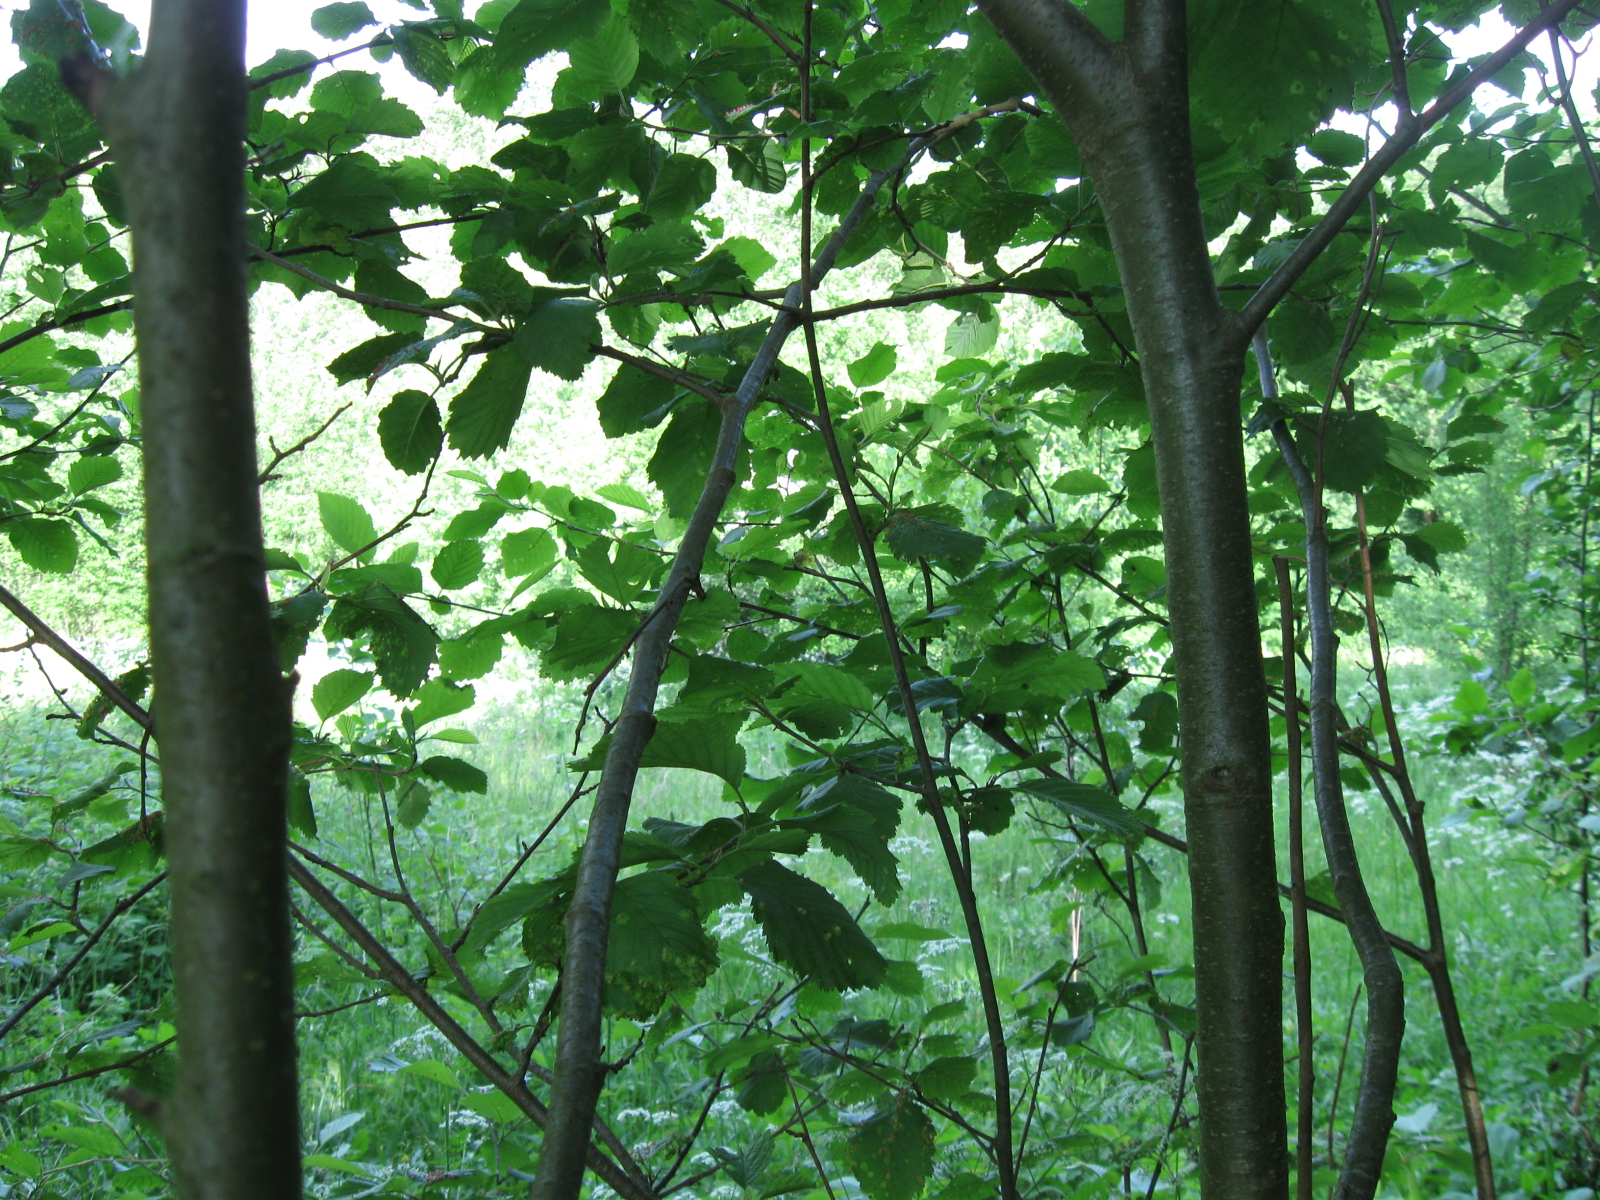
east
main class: Woodland
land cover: Broadleaved woodland
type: non-riverine alder, birch or aspen forest
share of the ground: 50 - 75 %
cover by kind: broadleaved forest trees 65 %, herbaceous plants 35 %
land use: Forestry
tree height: > 5 m
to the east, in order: Broadleaved woodland; Grassland with sparse tree/shrub cover; Broadleaved woodland; Tracks; Spontaneously vegetated surfaces; Electric lines; Spontaneously vegetated surfaces; Rivers and streams; Broadleaved woodland; Rivers and streams; Broadleaved woodland; Electric lines; Broadleaved woodland; Other mixed woodland
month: June
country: LT
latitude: 54.9926
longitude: 24.0176
